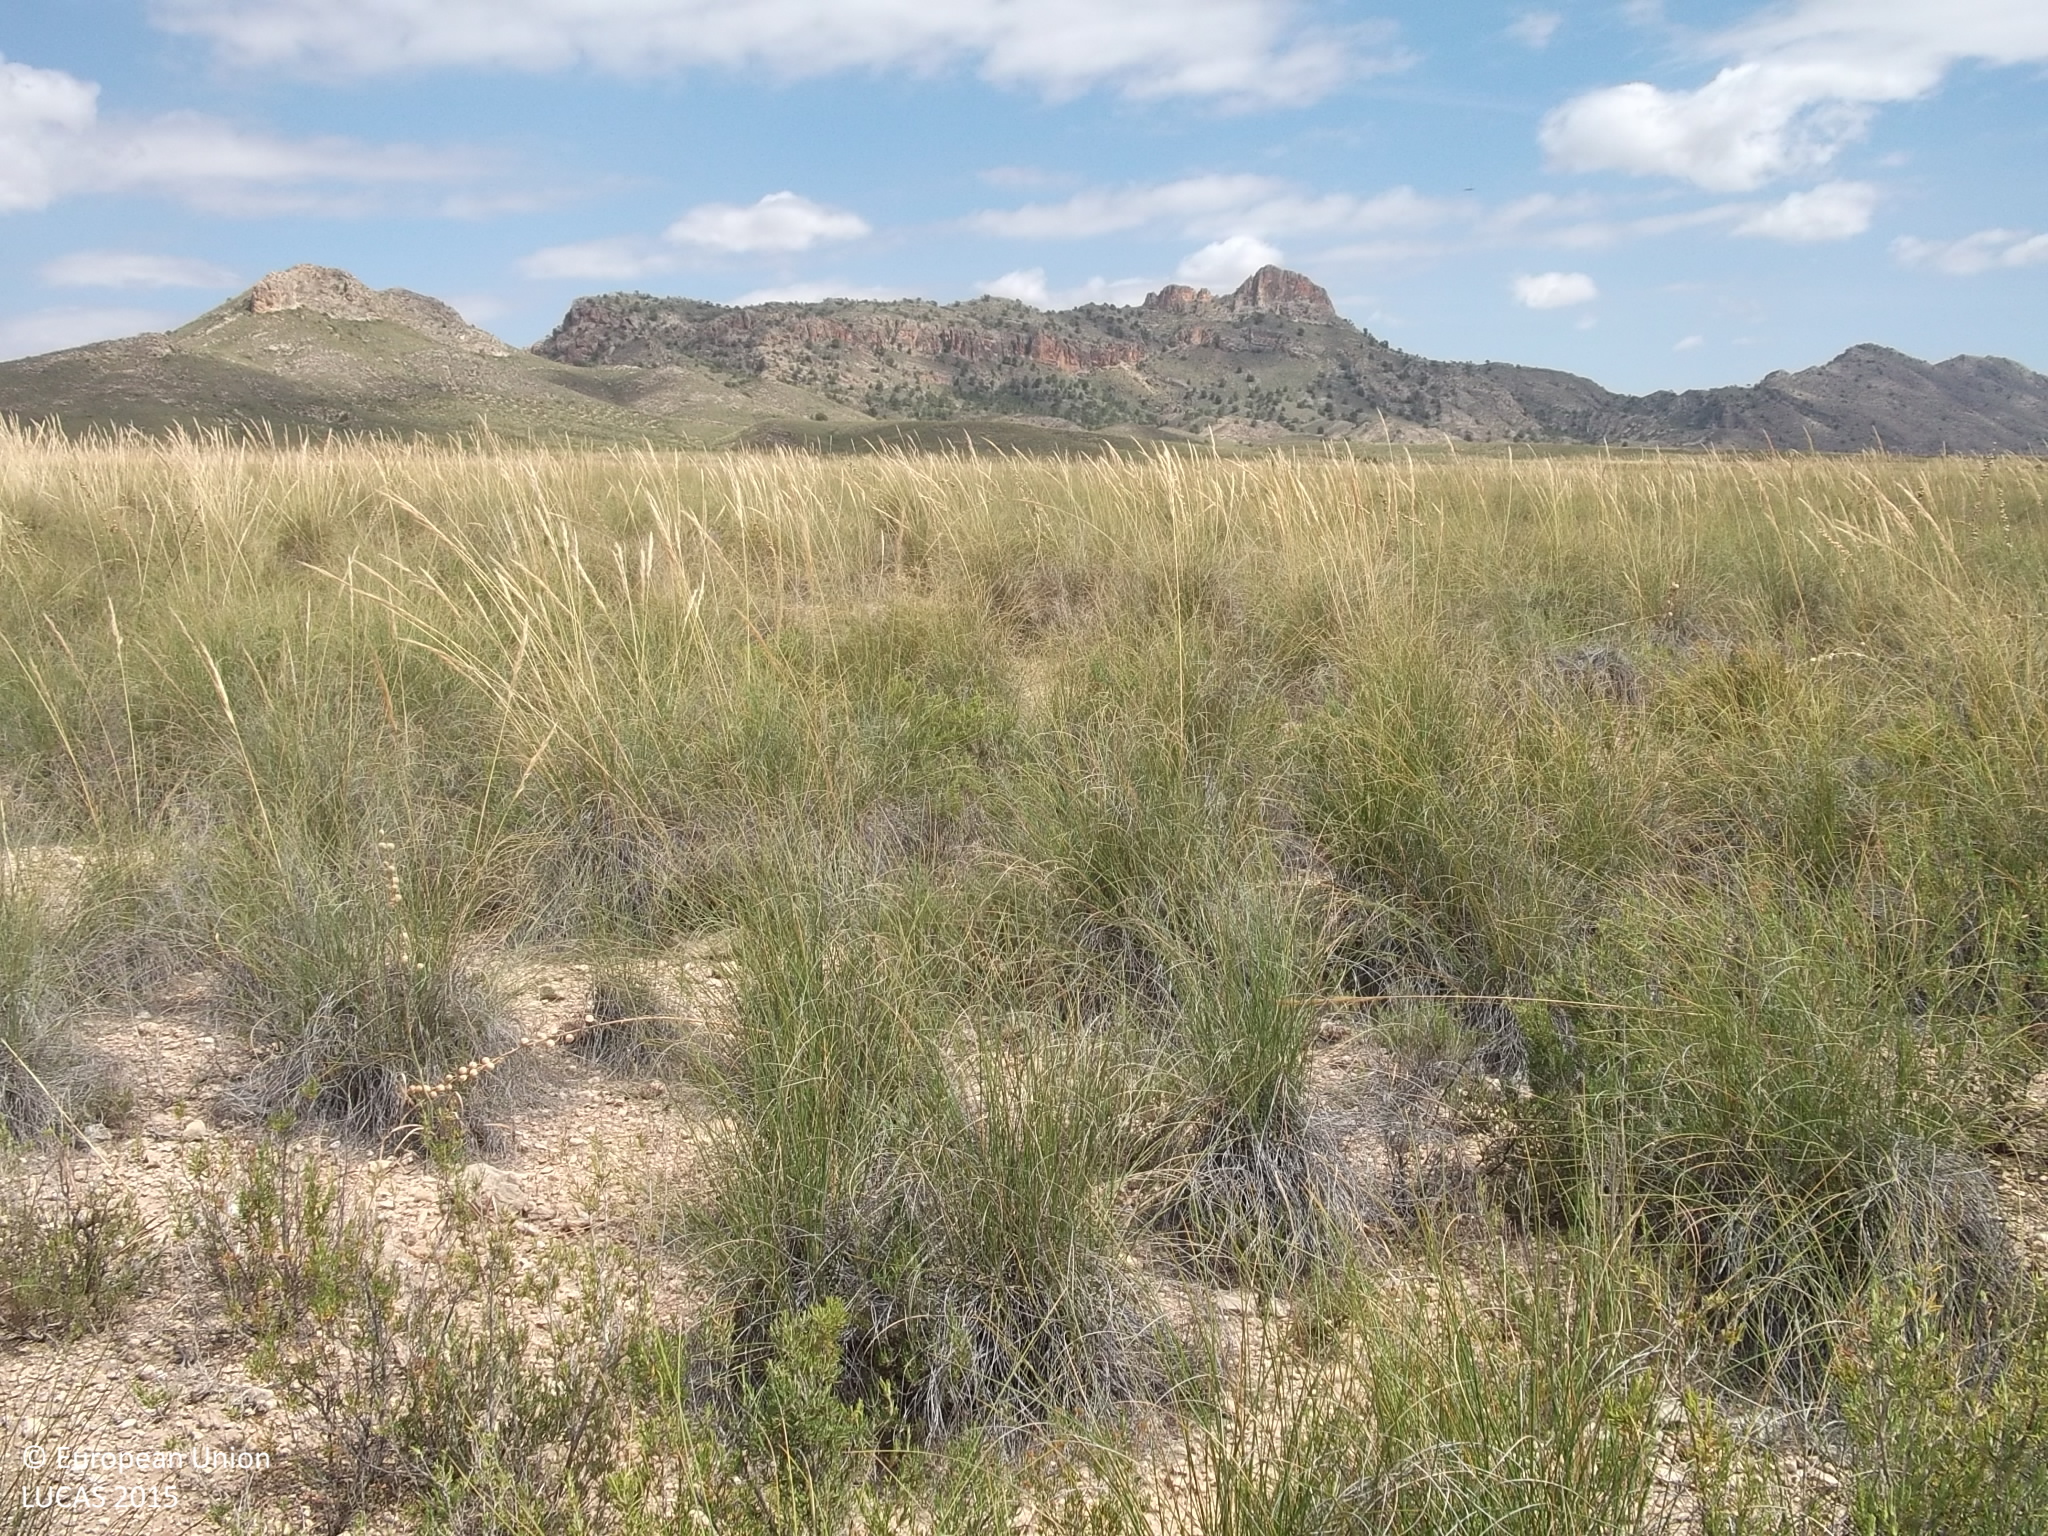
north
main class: Shrubland
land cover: Shrubland without tree cover
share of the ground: 25 - 50 %
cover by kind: shrubs 40 %, herbaceous plants 30 %, consolidated bare surface 30 %
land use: Semi-natural and natural areas not in use
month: May
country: ES
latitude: 38.3475
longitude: -1.4896
